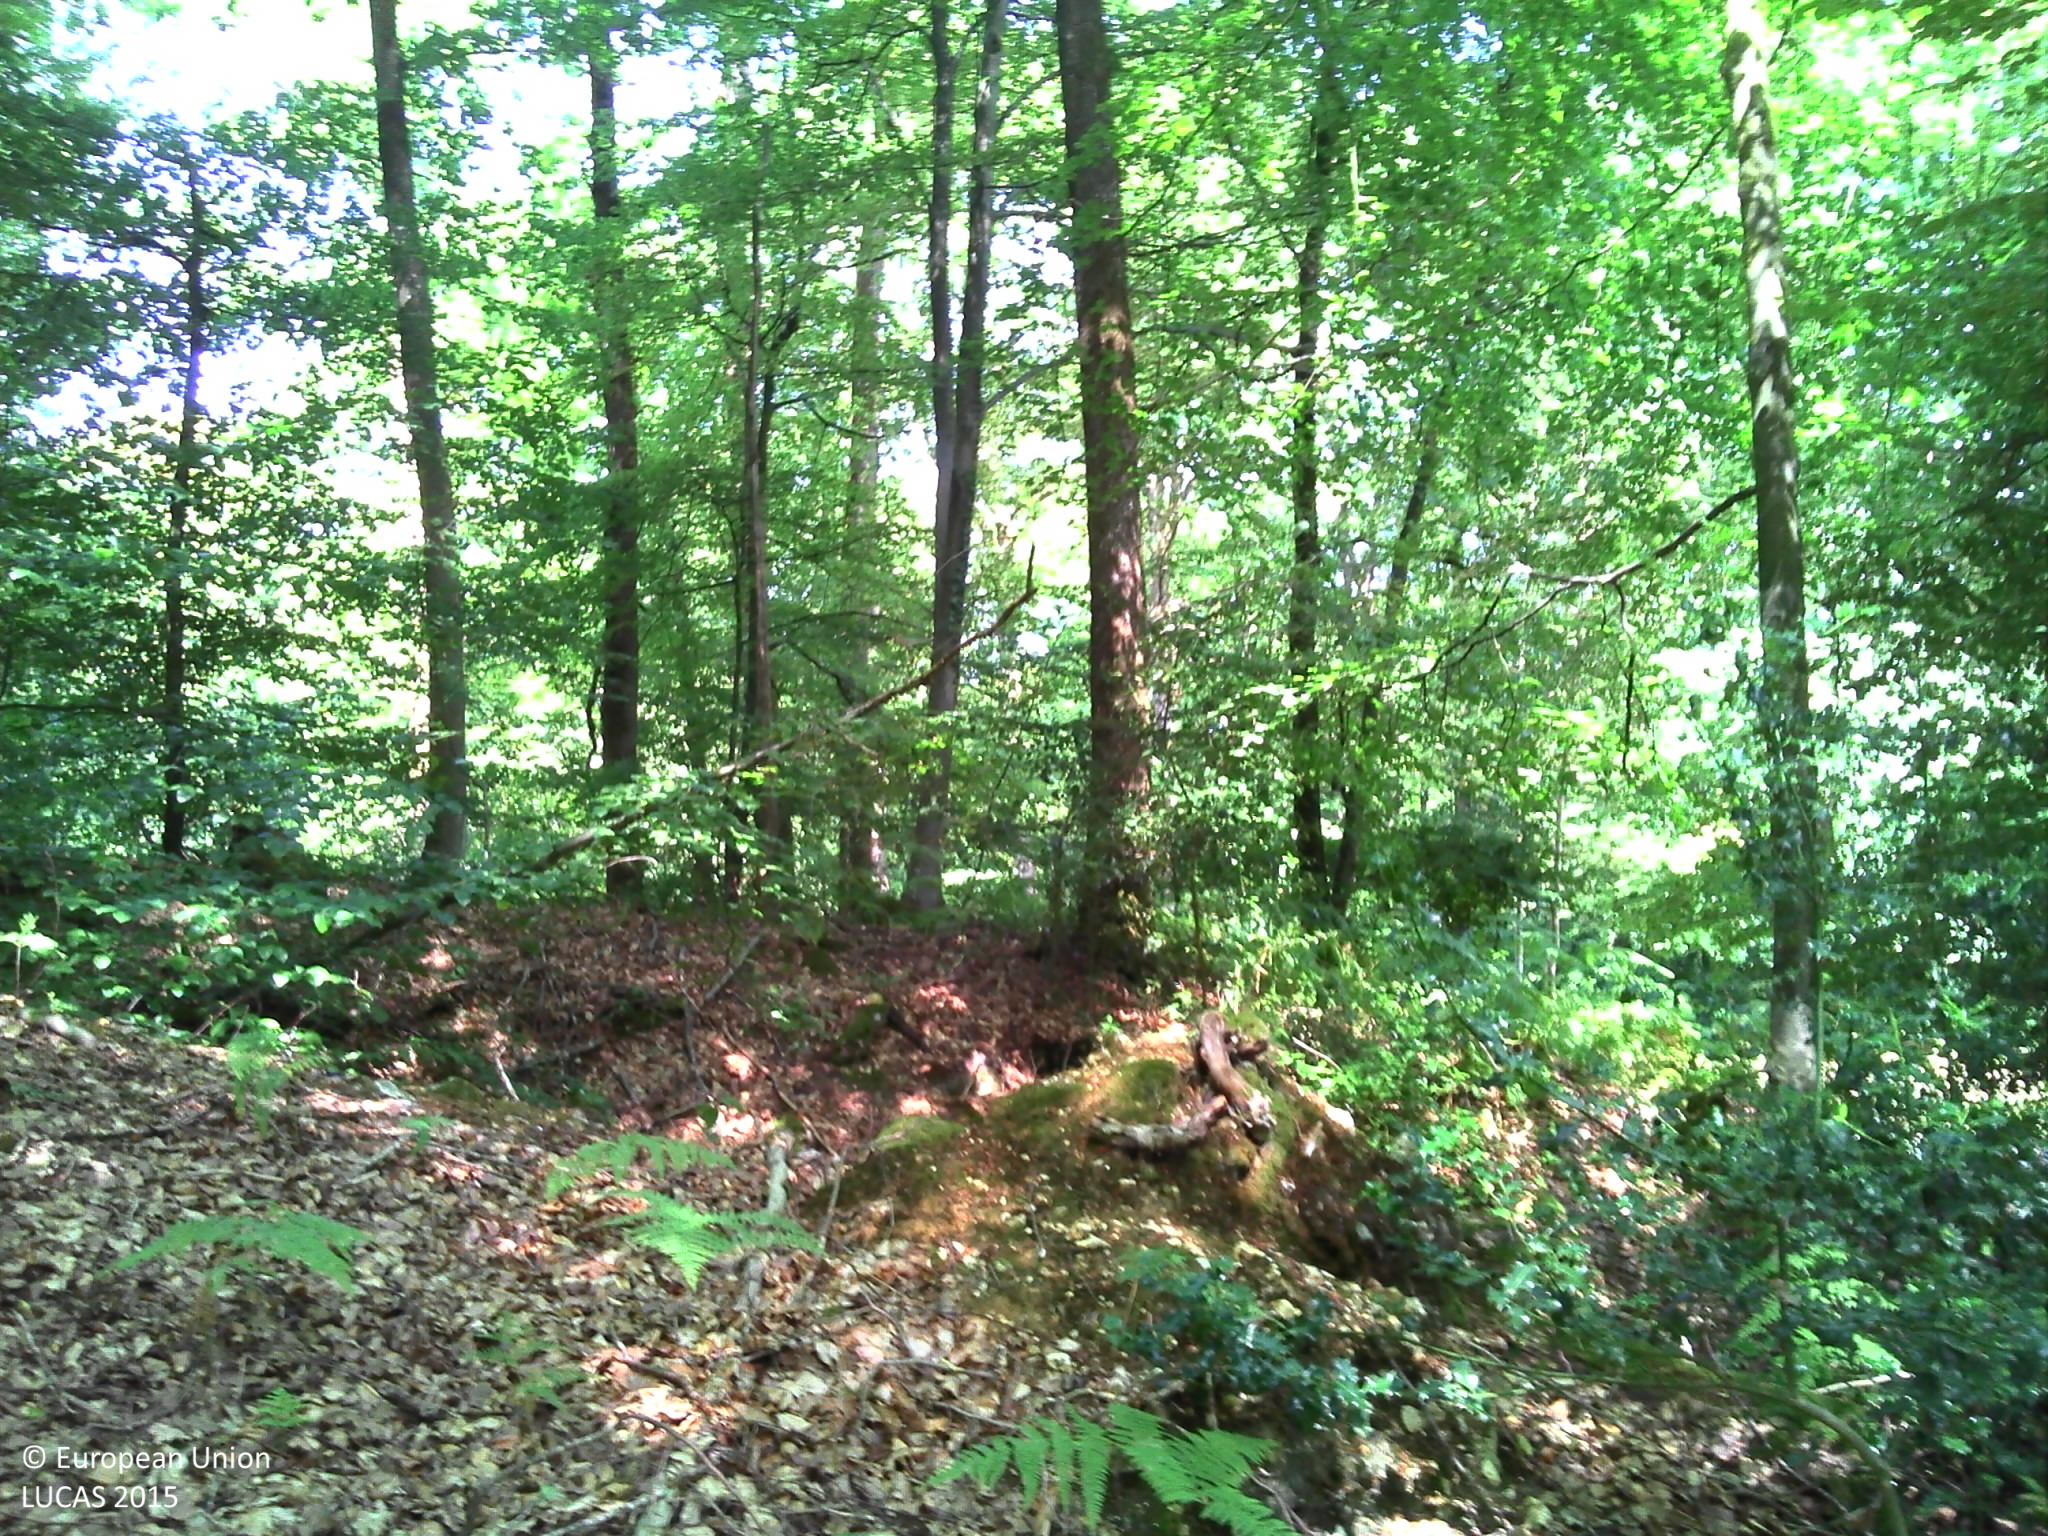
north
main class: Woodland
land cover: Broadleaved woodland
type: acidophilous oak and oak-birch forest
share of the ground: > 75 %
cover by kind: broadleaved forest trees 40 %, herbaceous plants 30 %, lichens and mosses 10 %, unconsolidated bare surface 10 %, consolidated bare surface 5 %
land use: Forestry
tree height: > 5 m
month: August
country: FR
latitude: 49.1335
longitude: 4.1707
